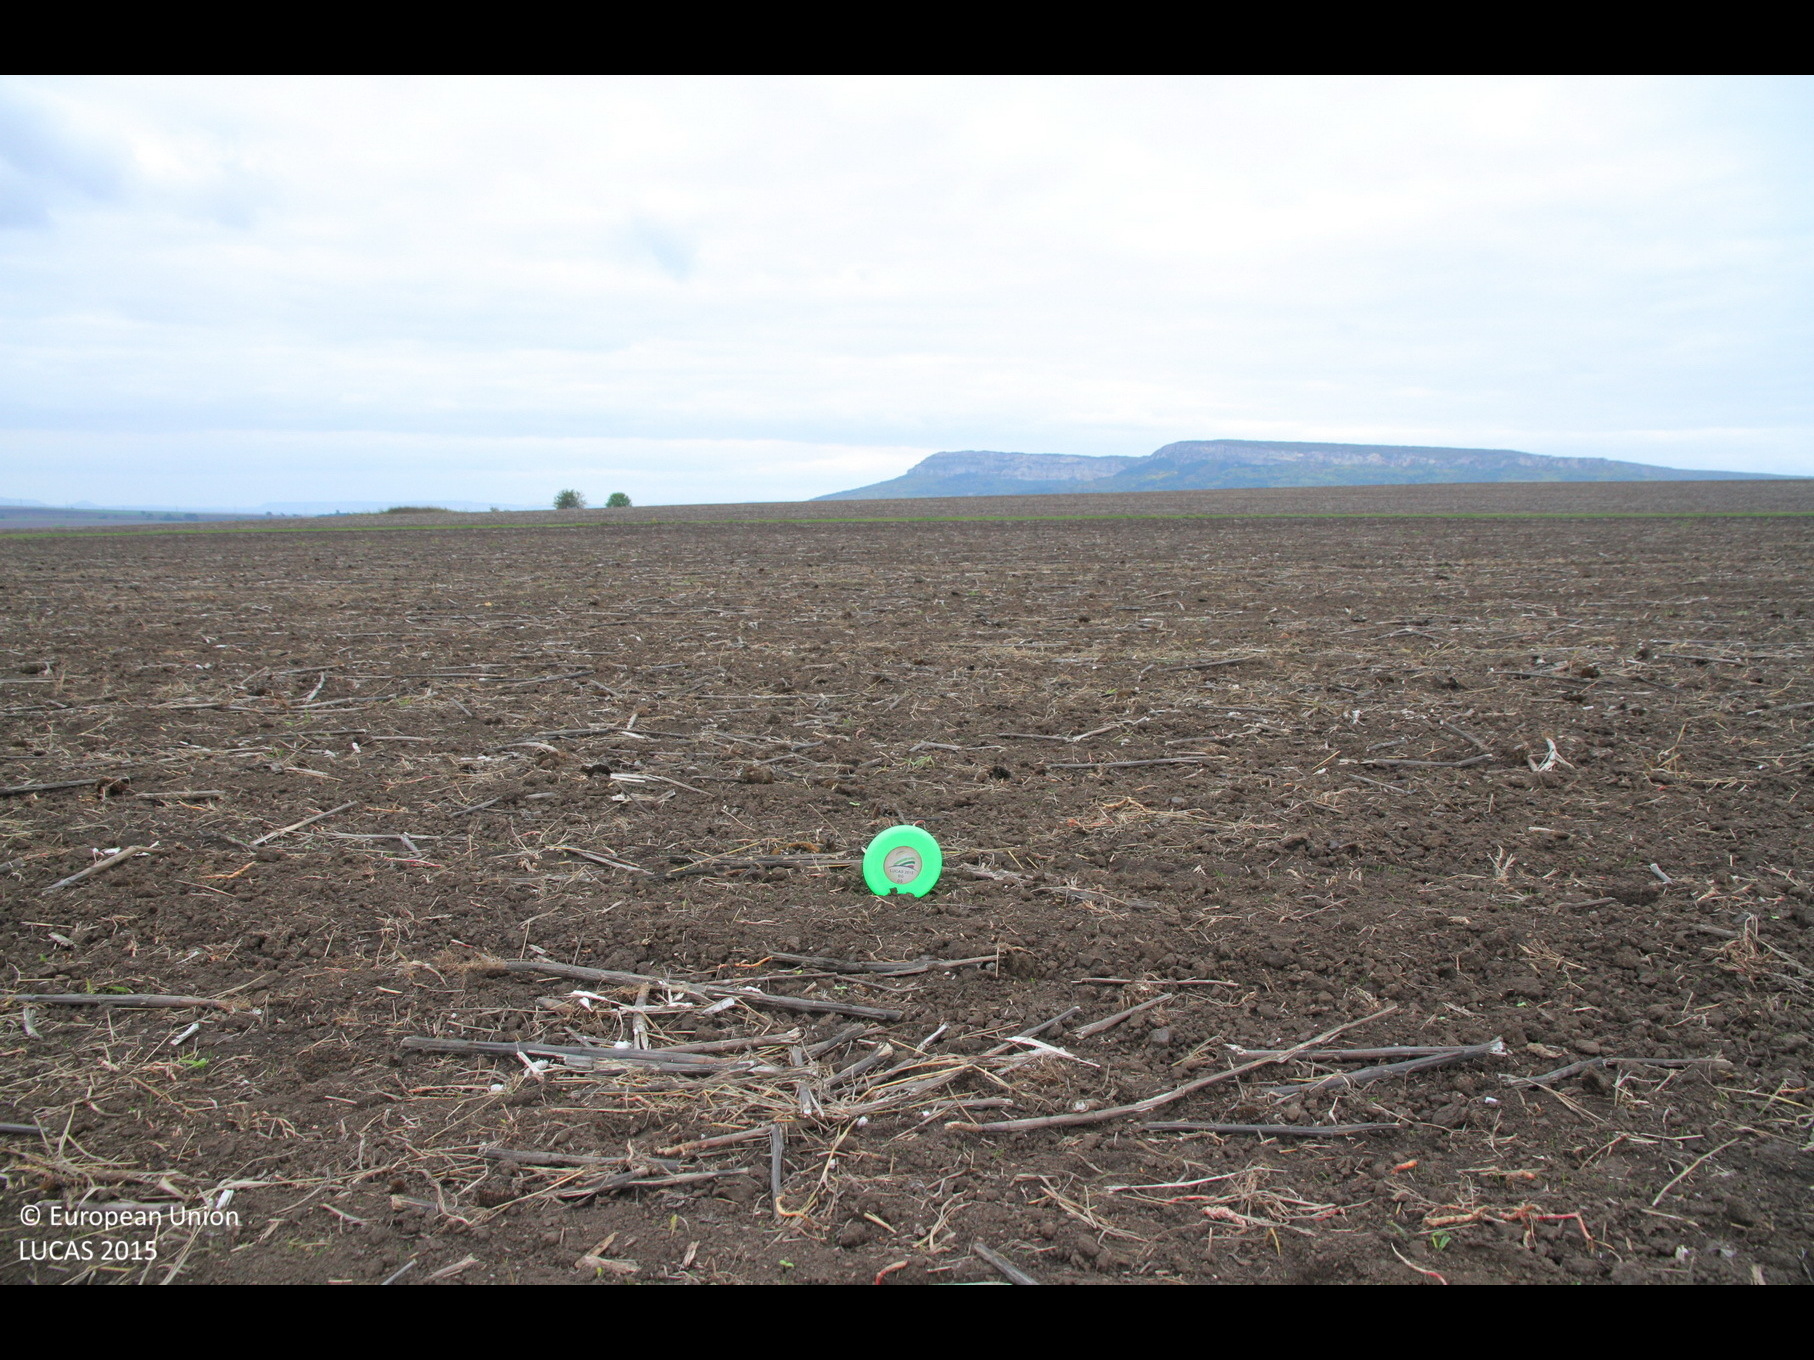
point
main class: Cropland
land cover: Sunflower
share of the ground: < 10 %
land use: Agriculture (excluding fallow land and kitchen gardens)
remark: Harvested field
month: October
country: BG
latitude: 43.2534
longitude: 27.0775
